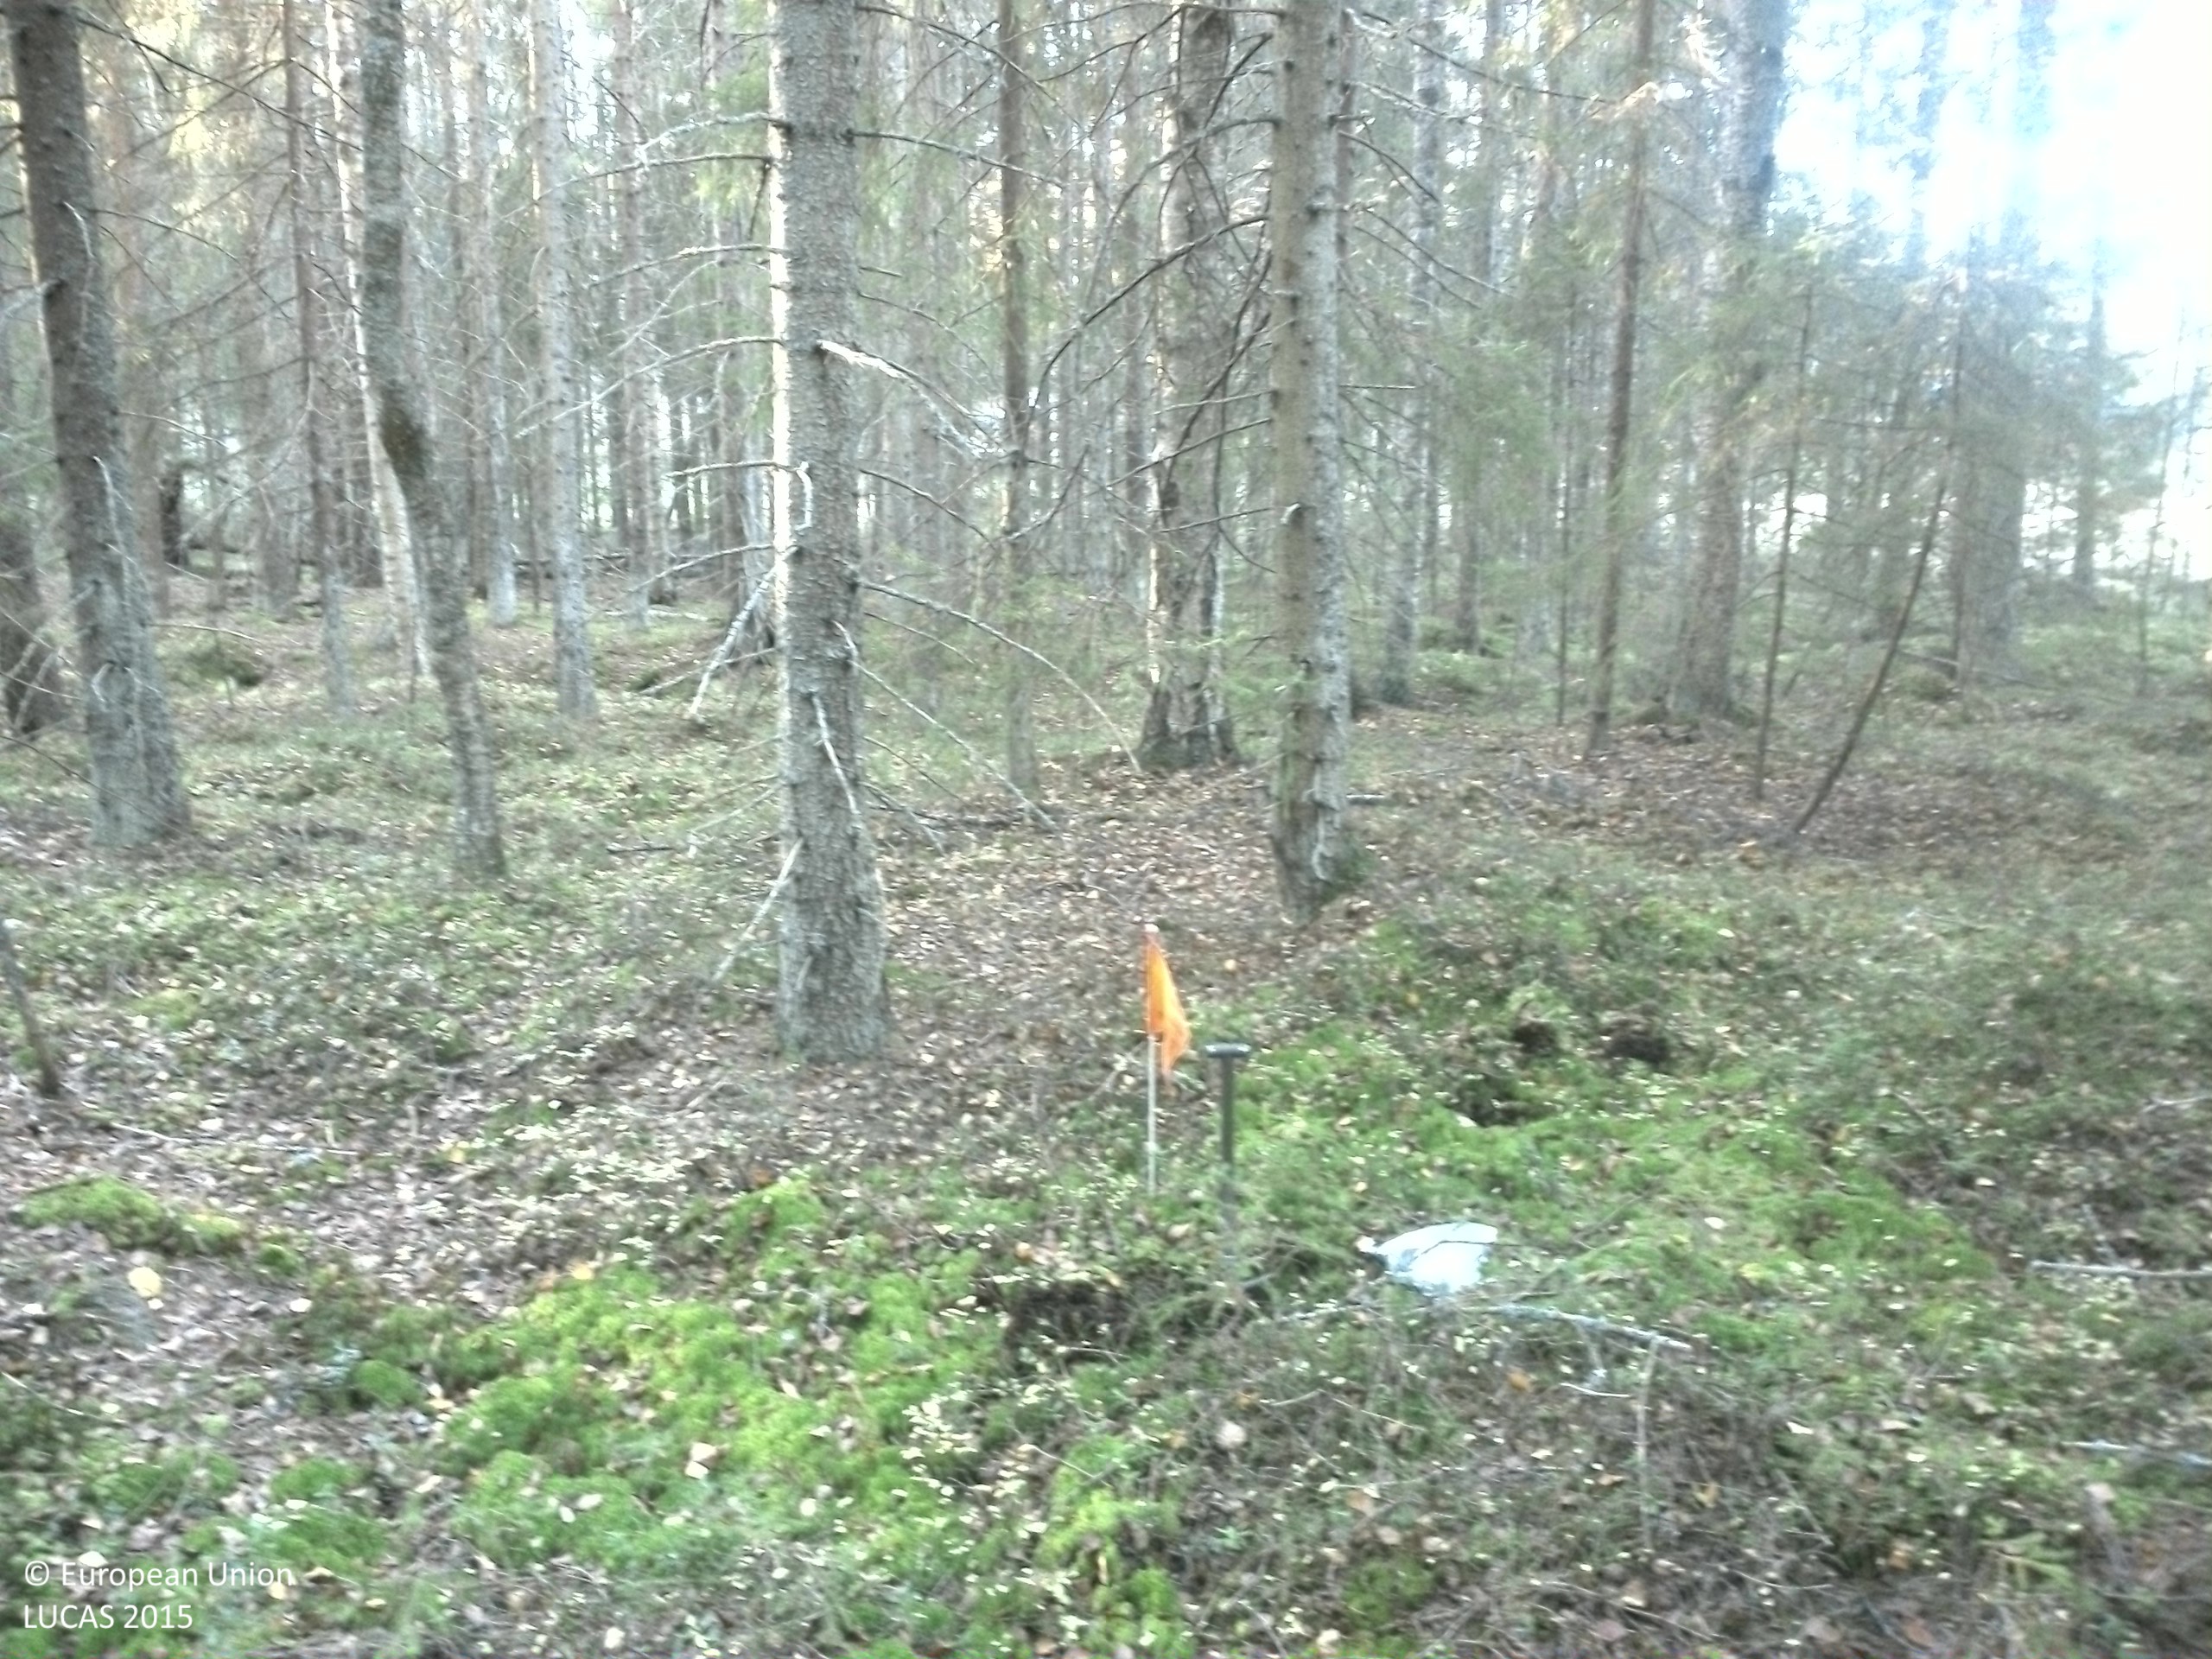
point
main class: Woodland
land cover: Spruce dominated coniferous woodland
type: boreal forest
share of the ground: > 75 %
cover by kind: coniferous forest trees 75 %, shrubs 15 %, lichens and mosses 10 %
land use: Forestry
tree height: > 5 m
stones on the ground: < 10 %
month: October
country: SE
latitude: 59.5625
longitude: 15.1760
